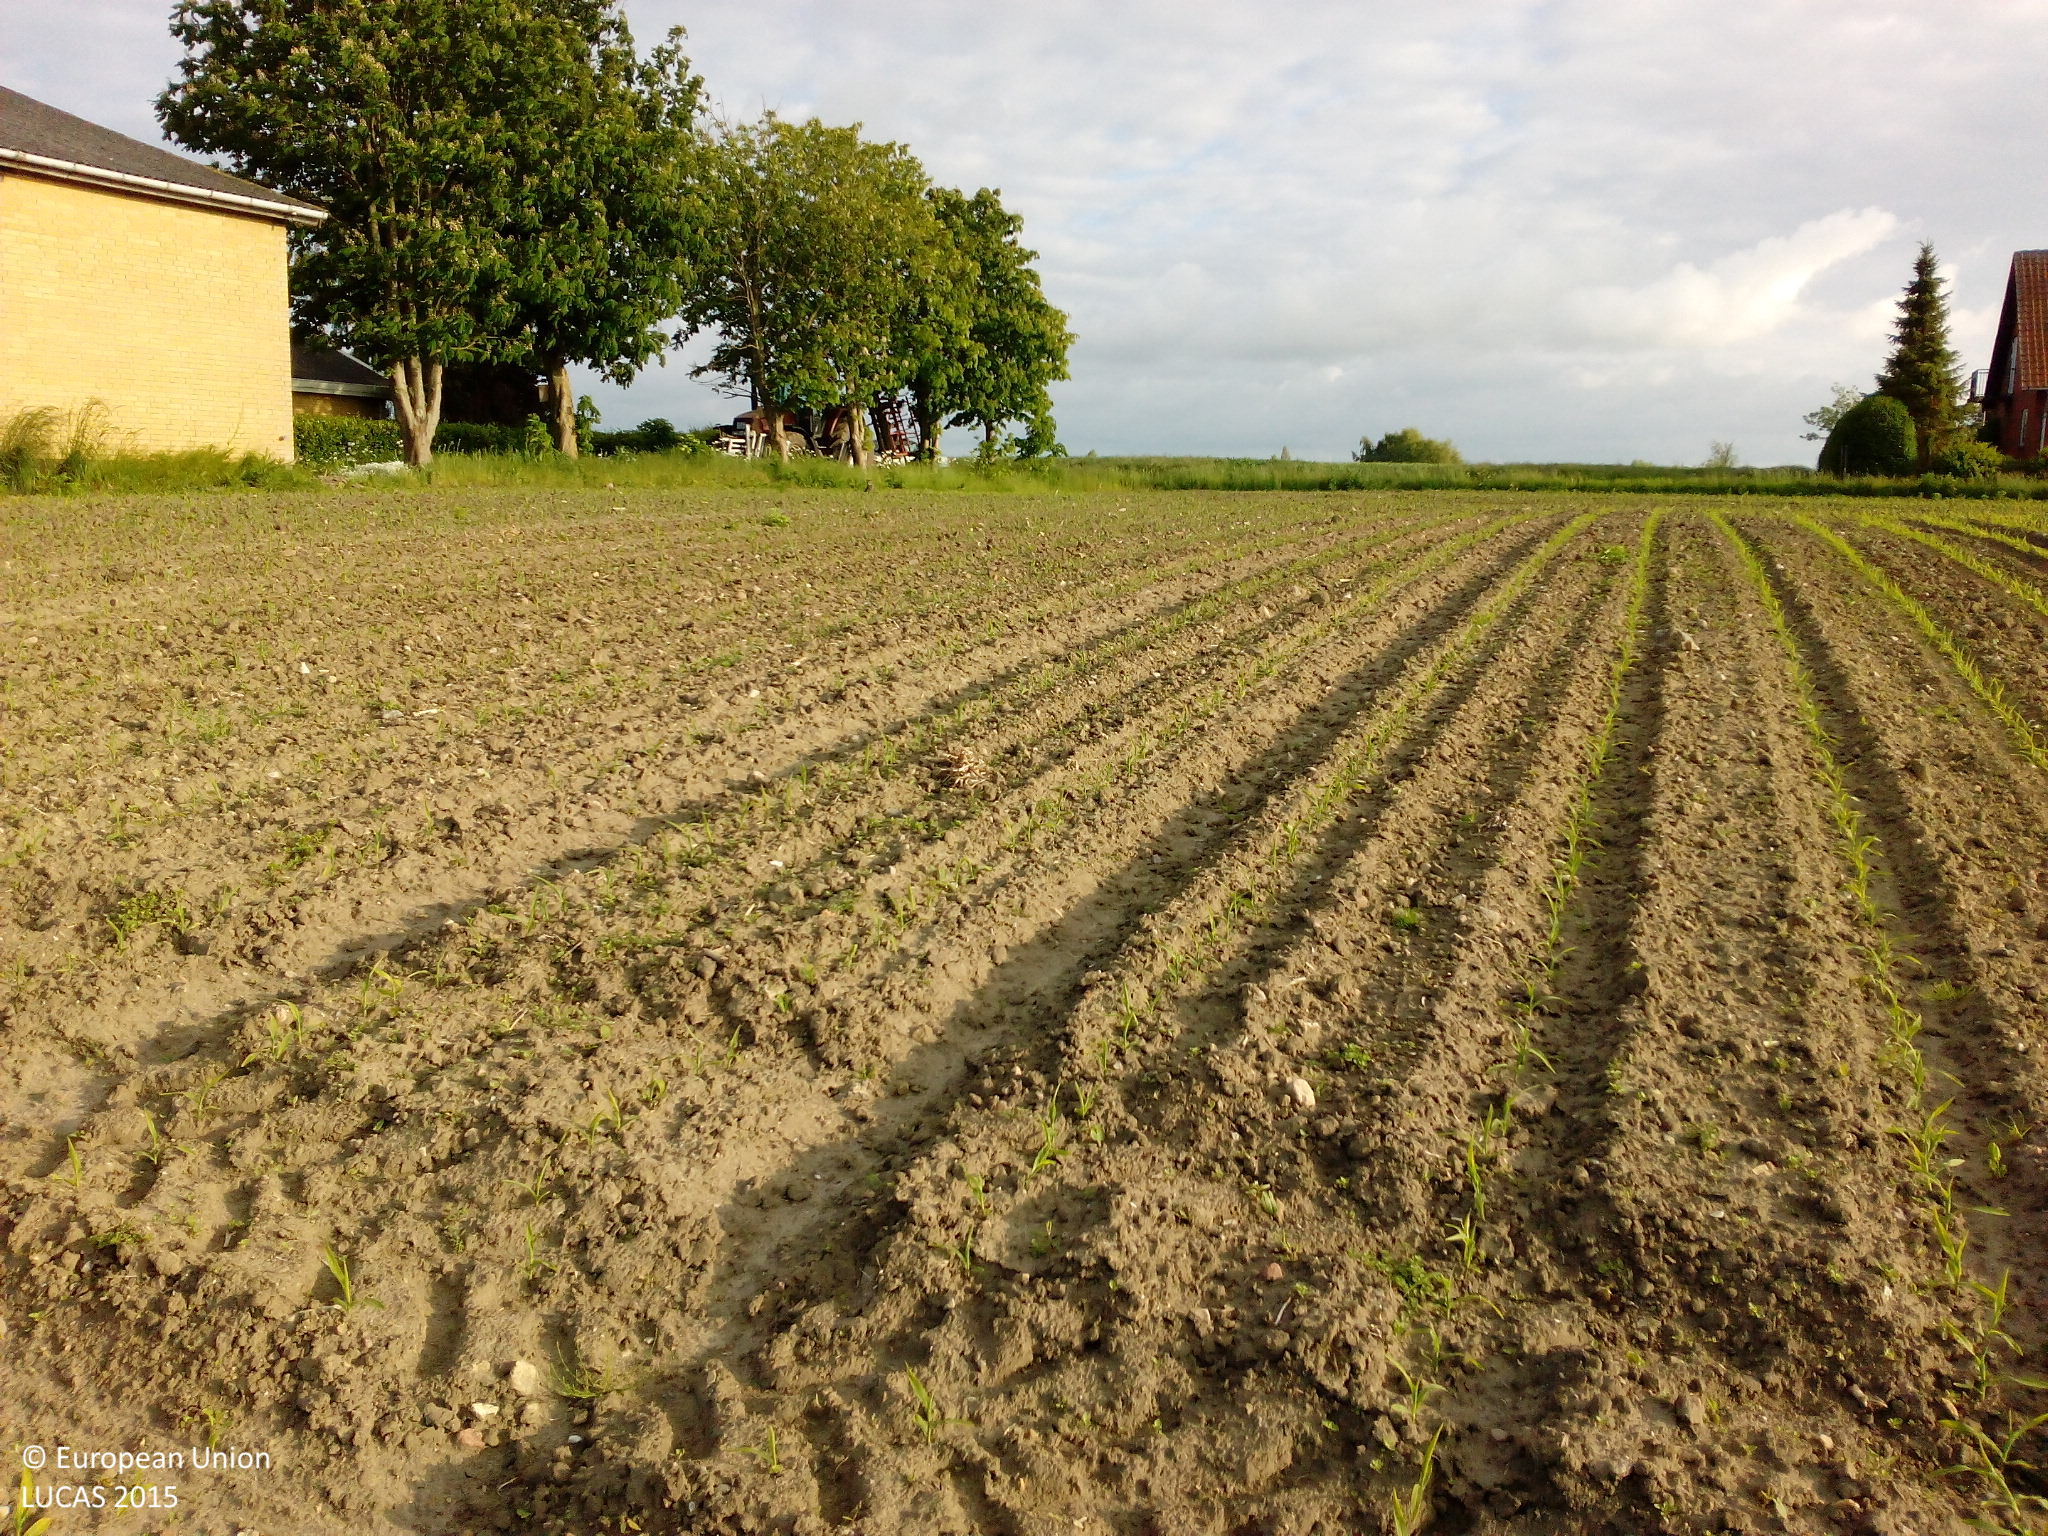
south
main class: Cropland
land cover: Maize
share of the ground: < 10 %
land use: Agriculture (excluding fallow land and kitchen gardens)
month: June
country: DK
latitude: 55.5210
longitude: 10.6488
